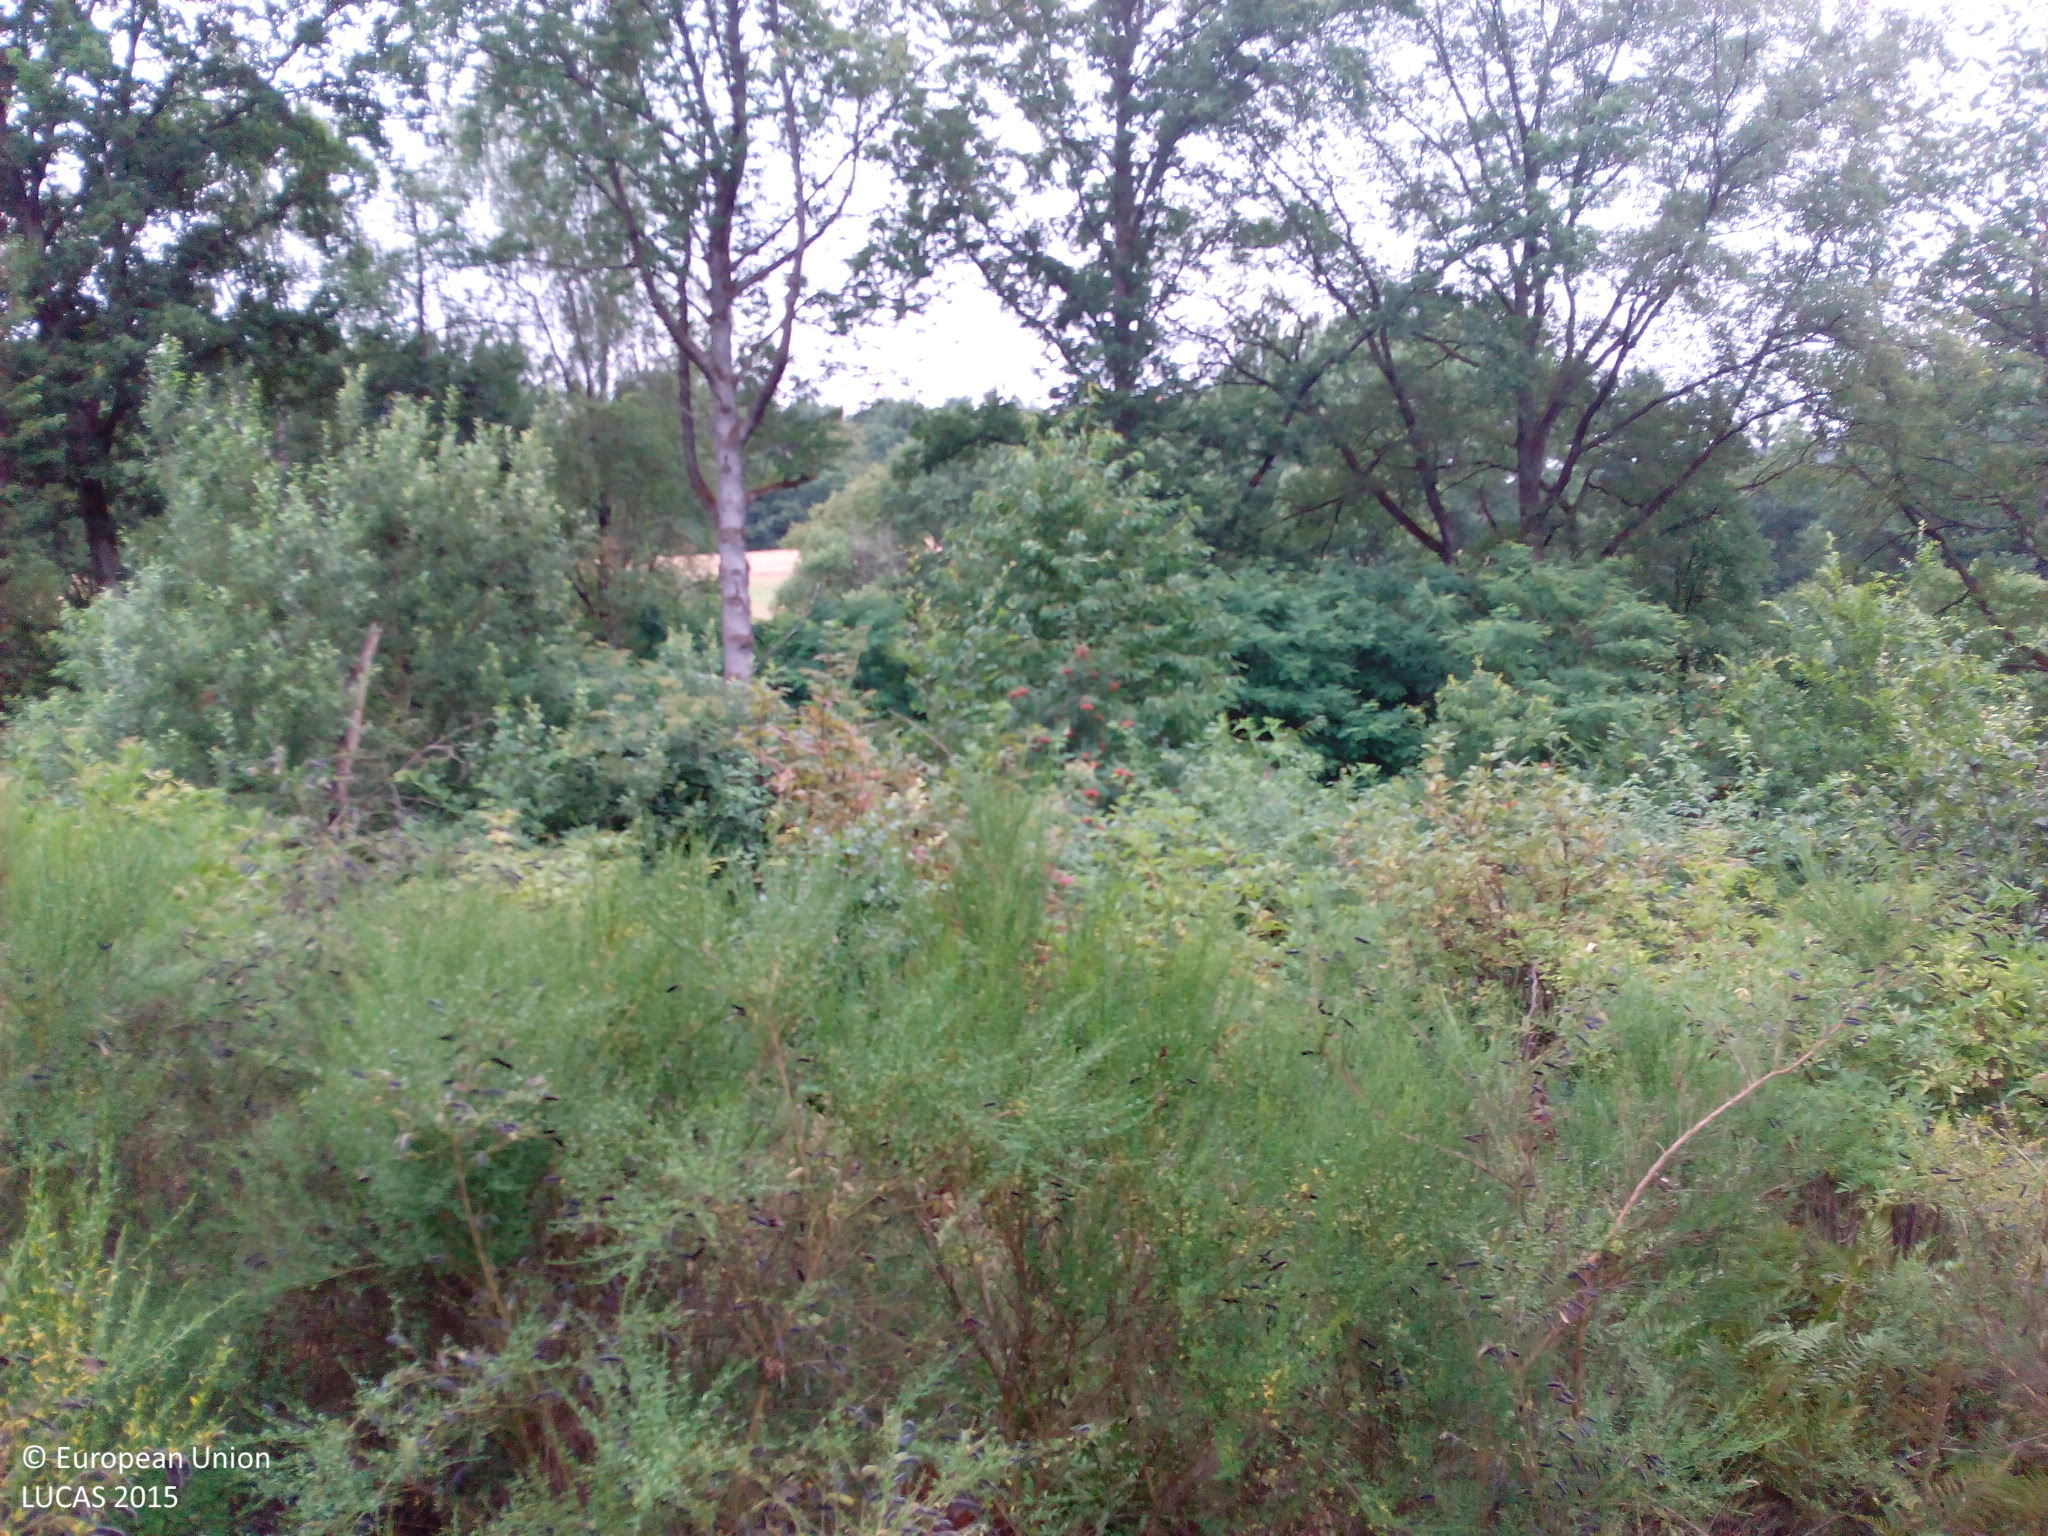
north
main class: Woodland
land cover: Broadleaved woodland
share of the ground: > 75 %
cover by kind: broadleaved forest trees 85 %, shrubs 10 %, herbaceous plants 5 %
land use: Forestry
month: July
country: DE
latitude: 49.5006
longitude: 7.1420
